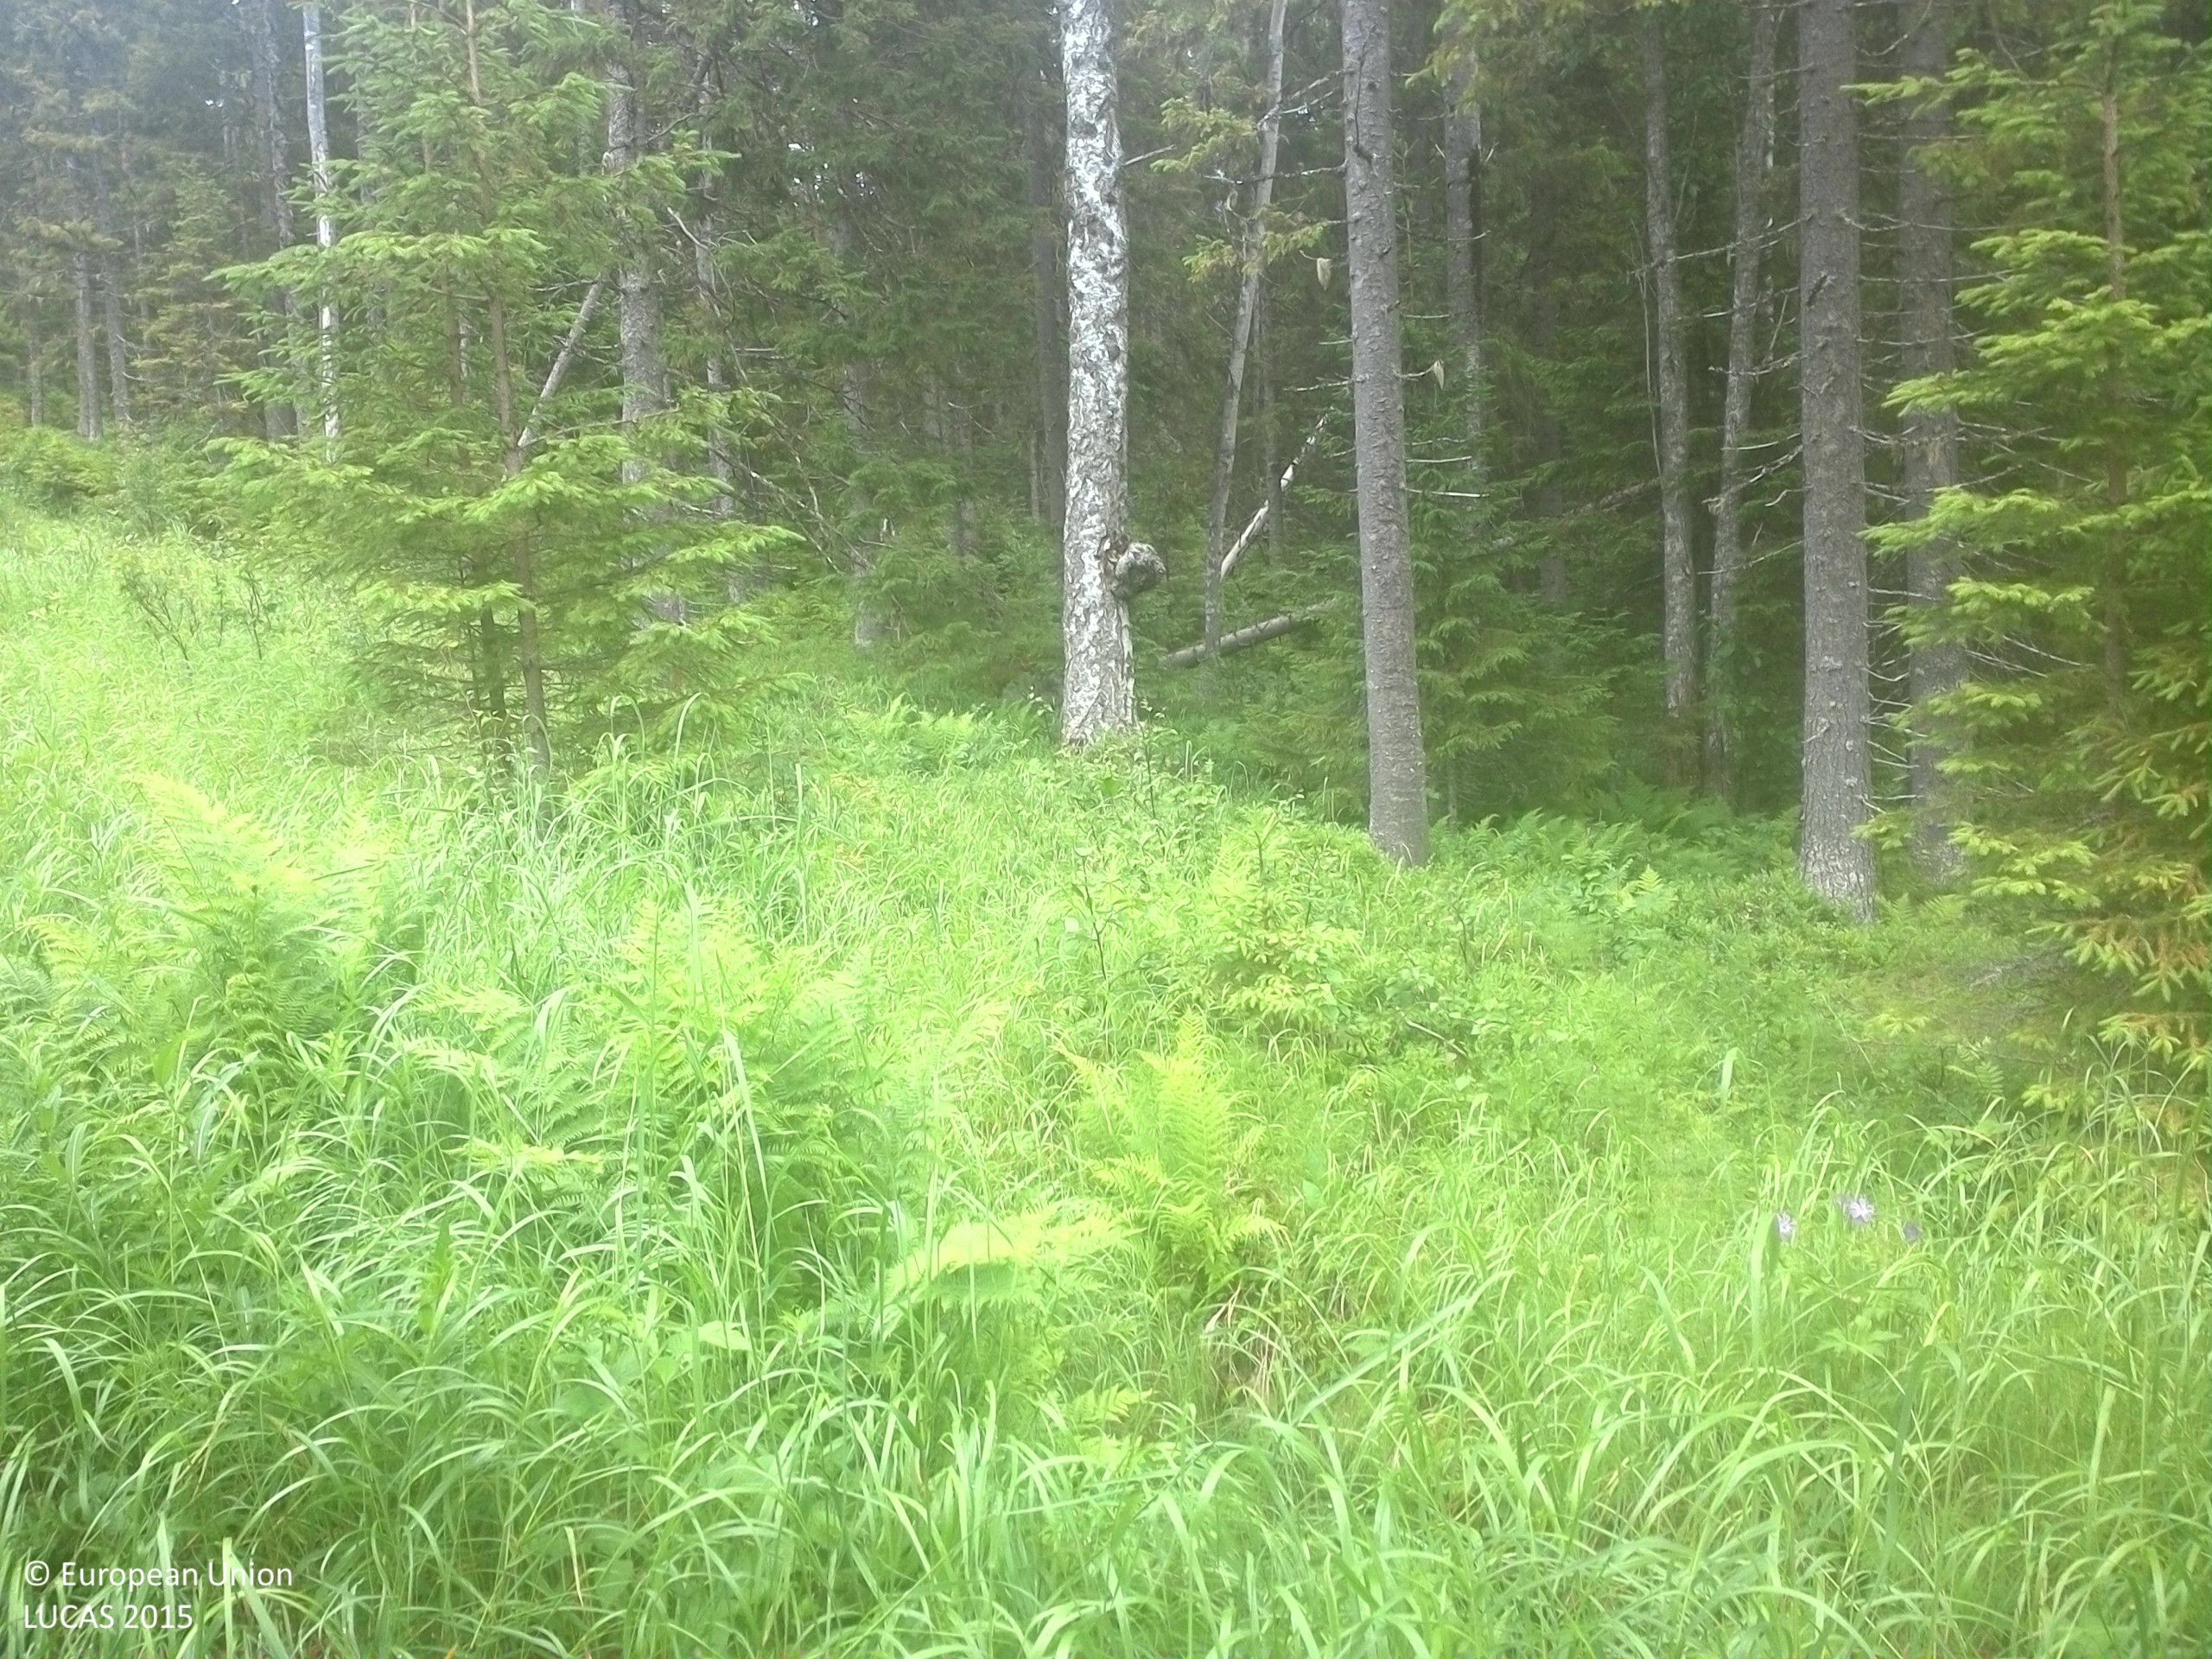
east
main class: Woodland
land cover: Spruce dominated coniferous woodland
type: boreal forest
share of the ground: 50 - 75 %
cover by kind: coniferous forest trees 60 %, herbaceous plants 30 %, broadleaved forest trees 10 %
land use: Forestry
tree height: < 5 m
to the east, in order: Spruce dominated coniferous woodland; Spruce dominated mixed woodland; Spruce dominated coniferous woodland; Pine dominated coniferous woodland; Spruce dominated coniferous woodland
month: July
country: SE
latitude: 63.5886
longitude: 18.4989
